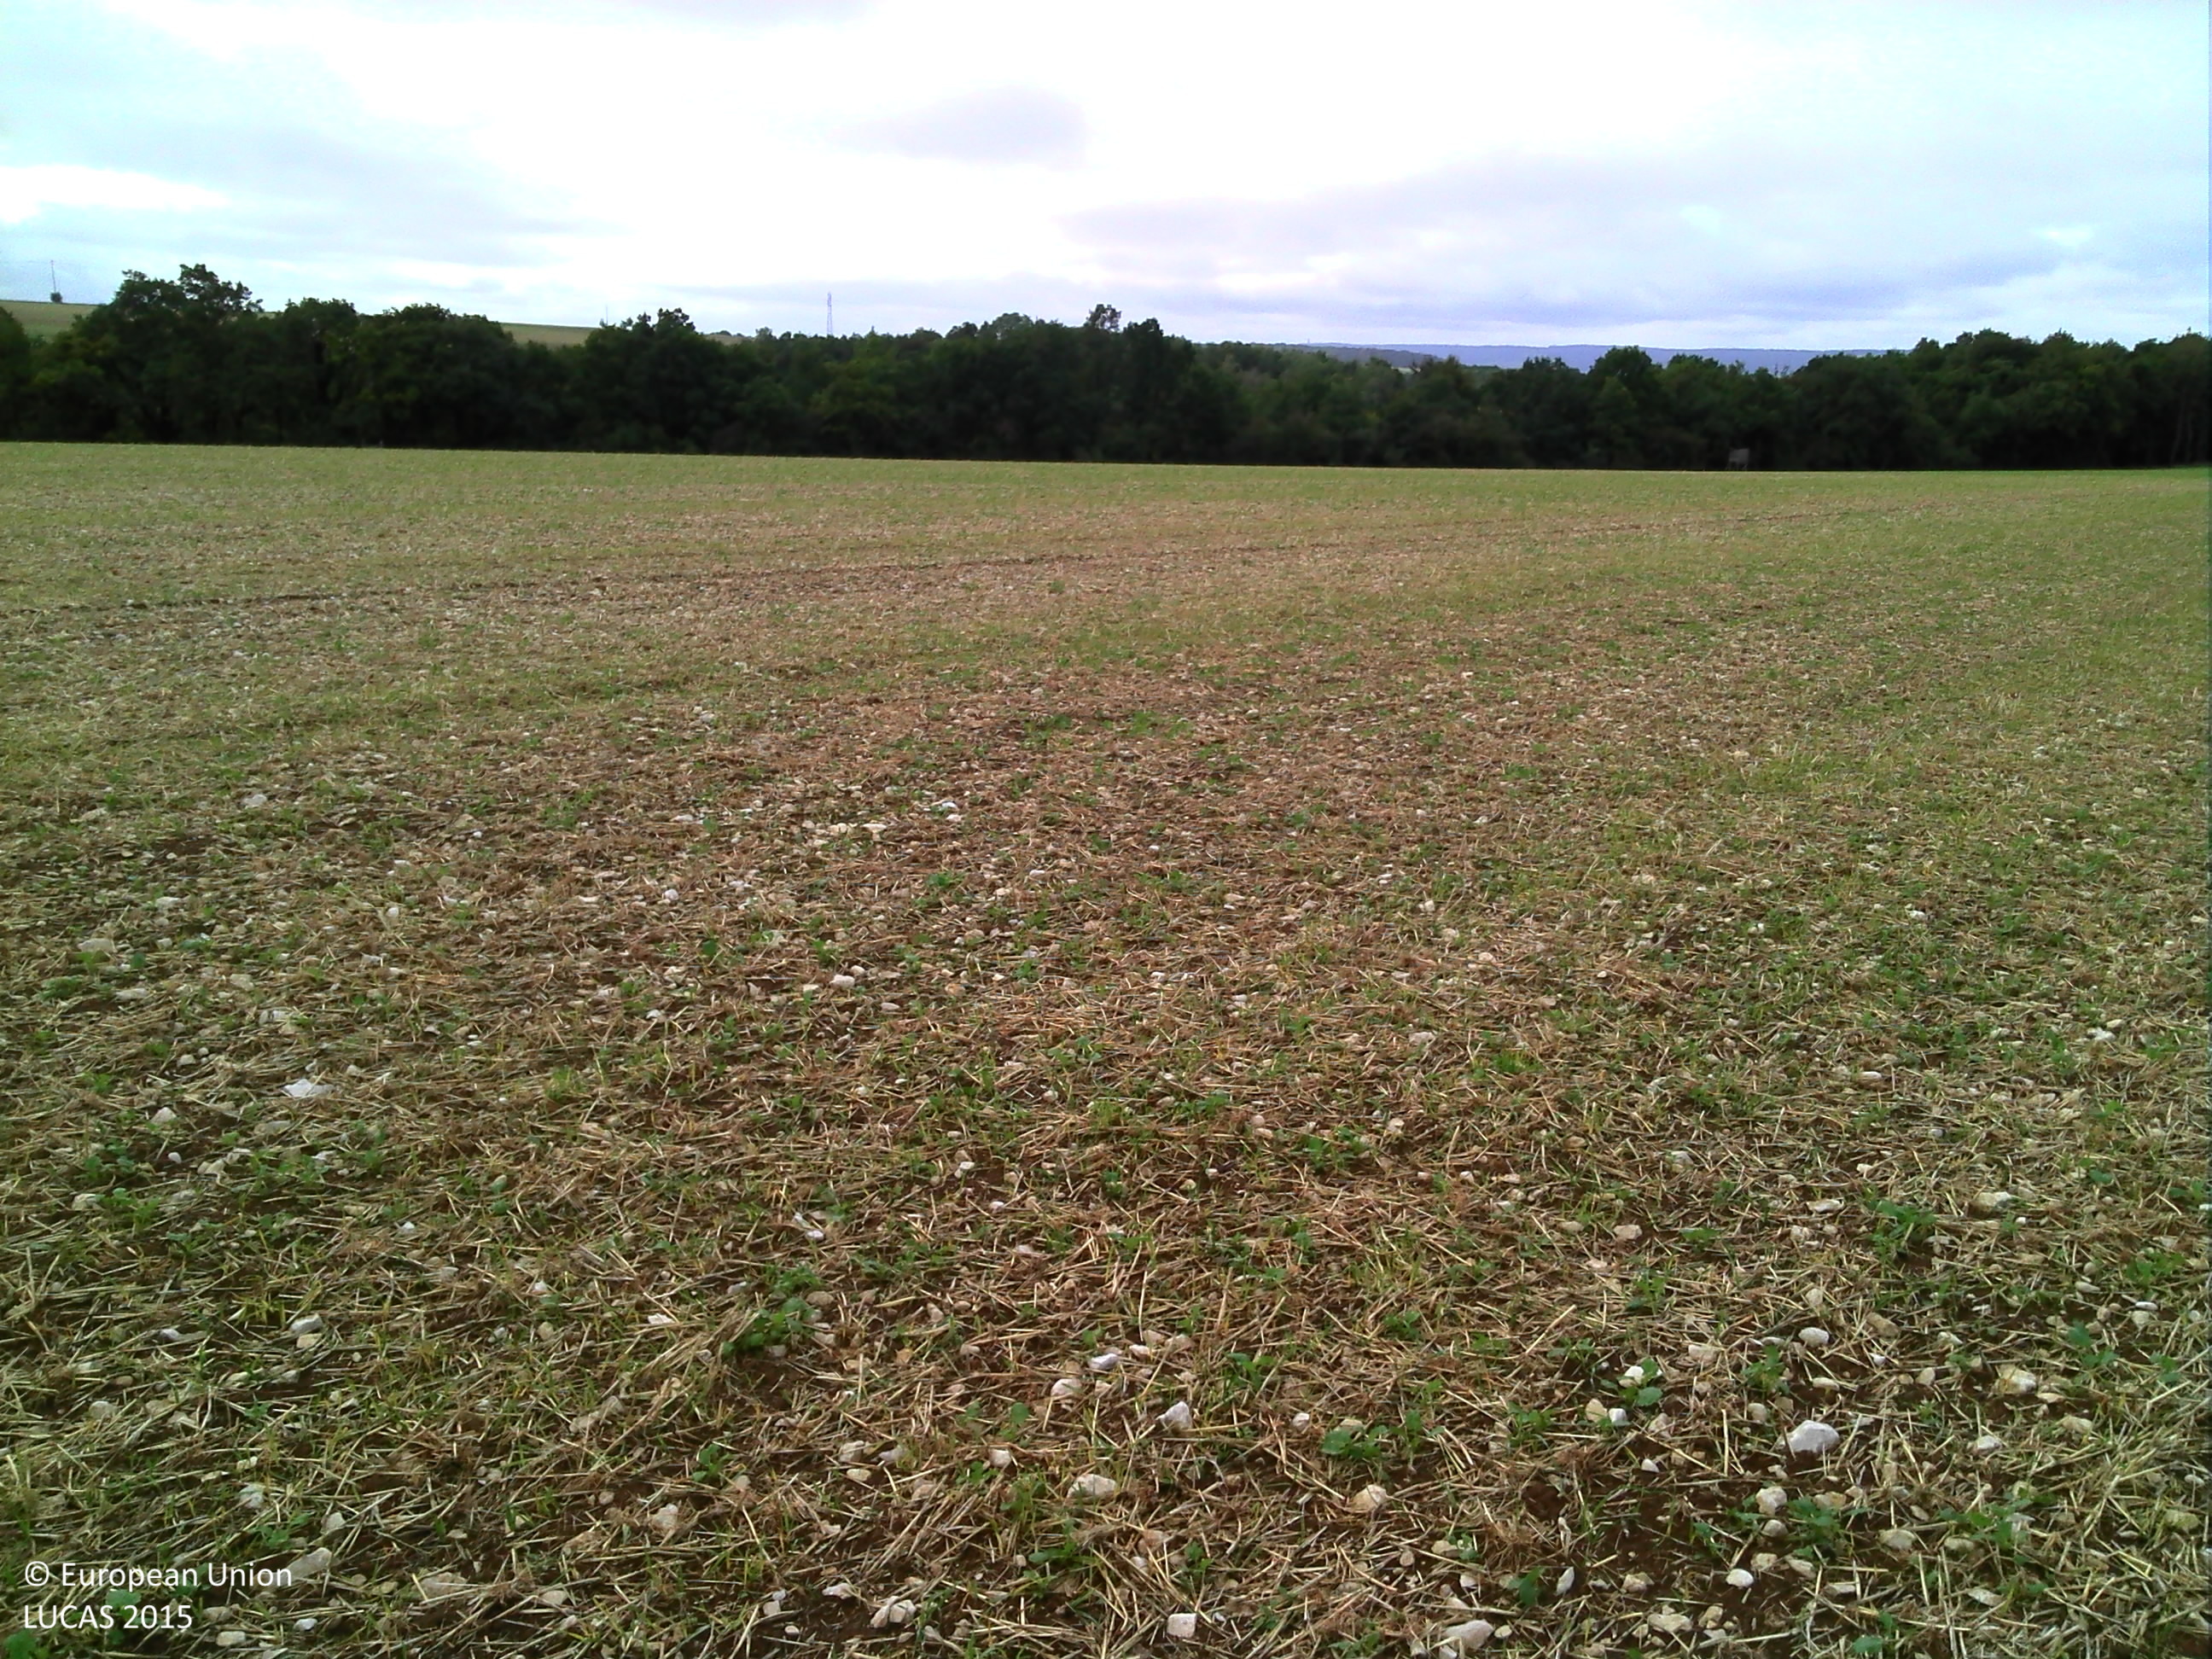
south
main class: Cropland
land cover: Rape and turnip rape
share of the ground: < 10 %
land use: Agriculture (excluding fallow land and kitchen gardens)
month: September
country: FR
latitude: 48.2804
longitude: 4.7832
